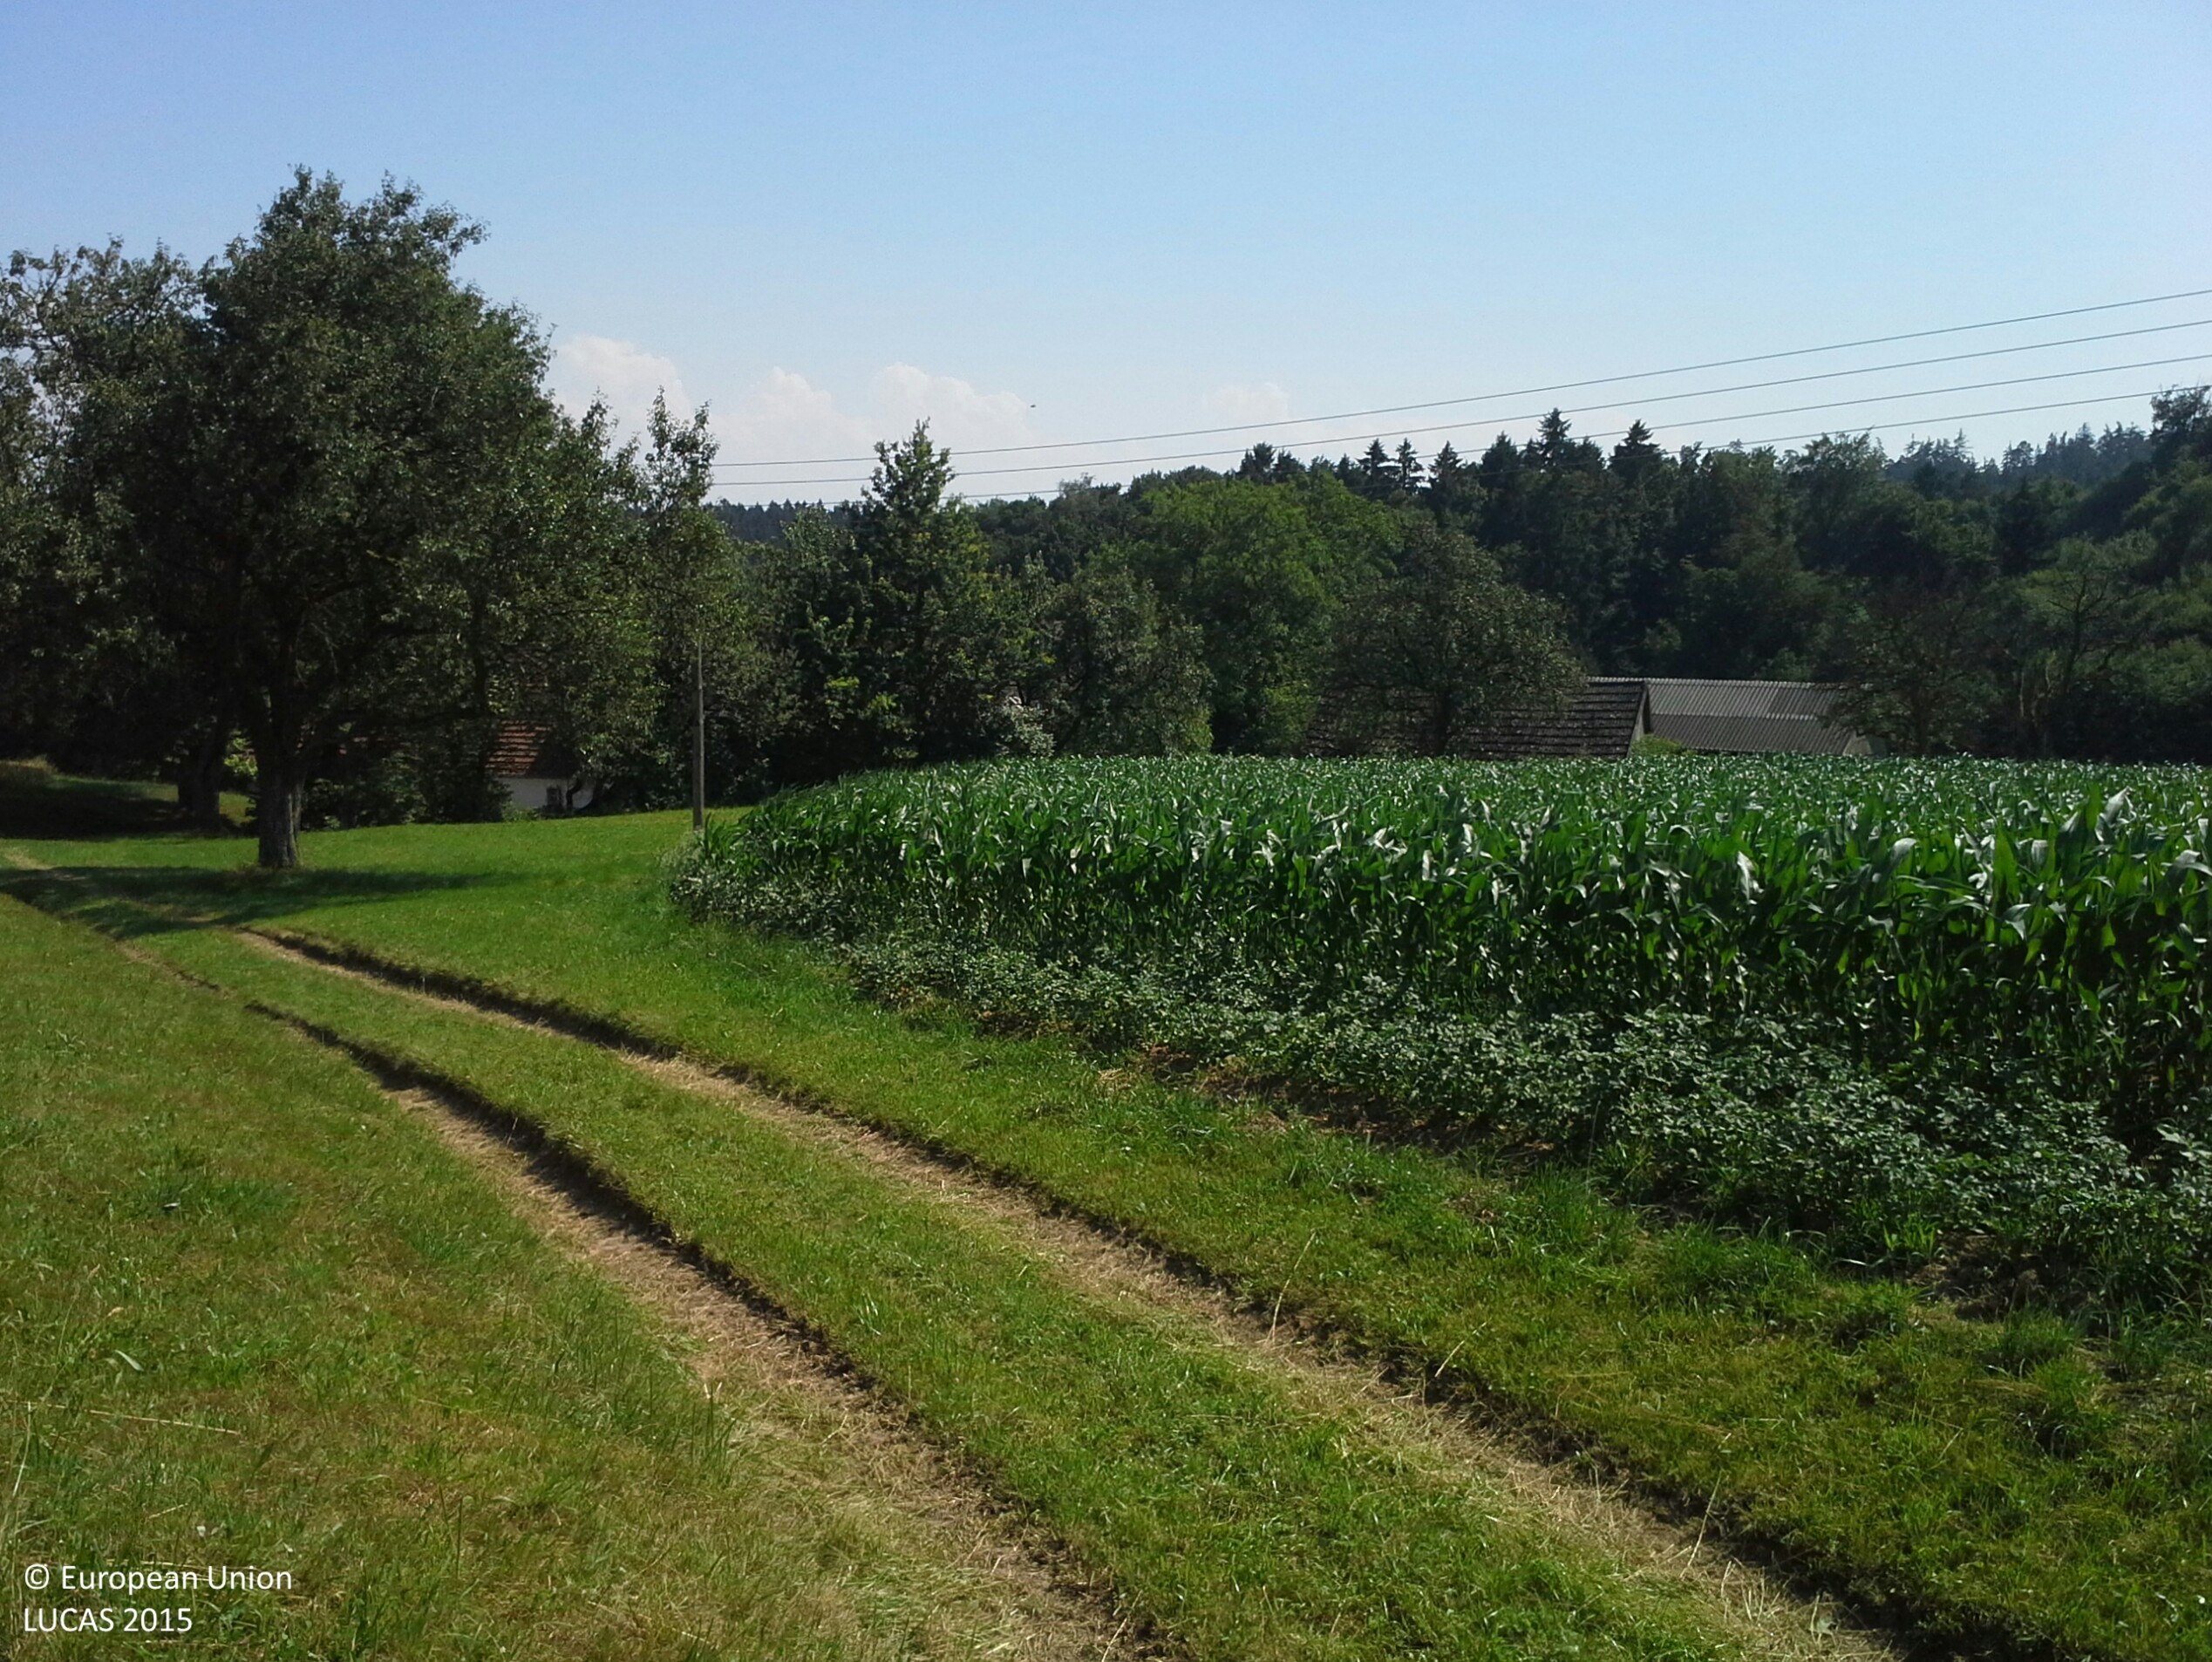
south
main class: Grassland
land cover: Grassland without tree/shrub cover
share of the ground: > 75 %
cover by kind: herbaceous plants 100 %
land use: Agriculture (excluding fallow land and kitchen gardens)
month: July
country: AT
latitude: 48.1802
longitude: 15.0448
